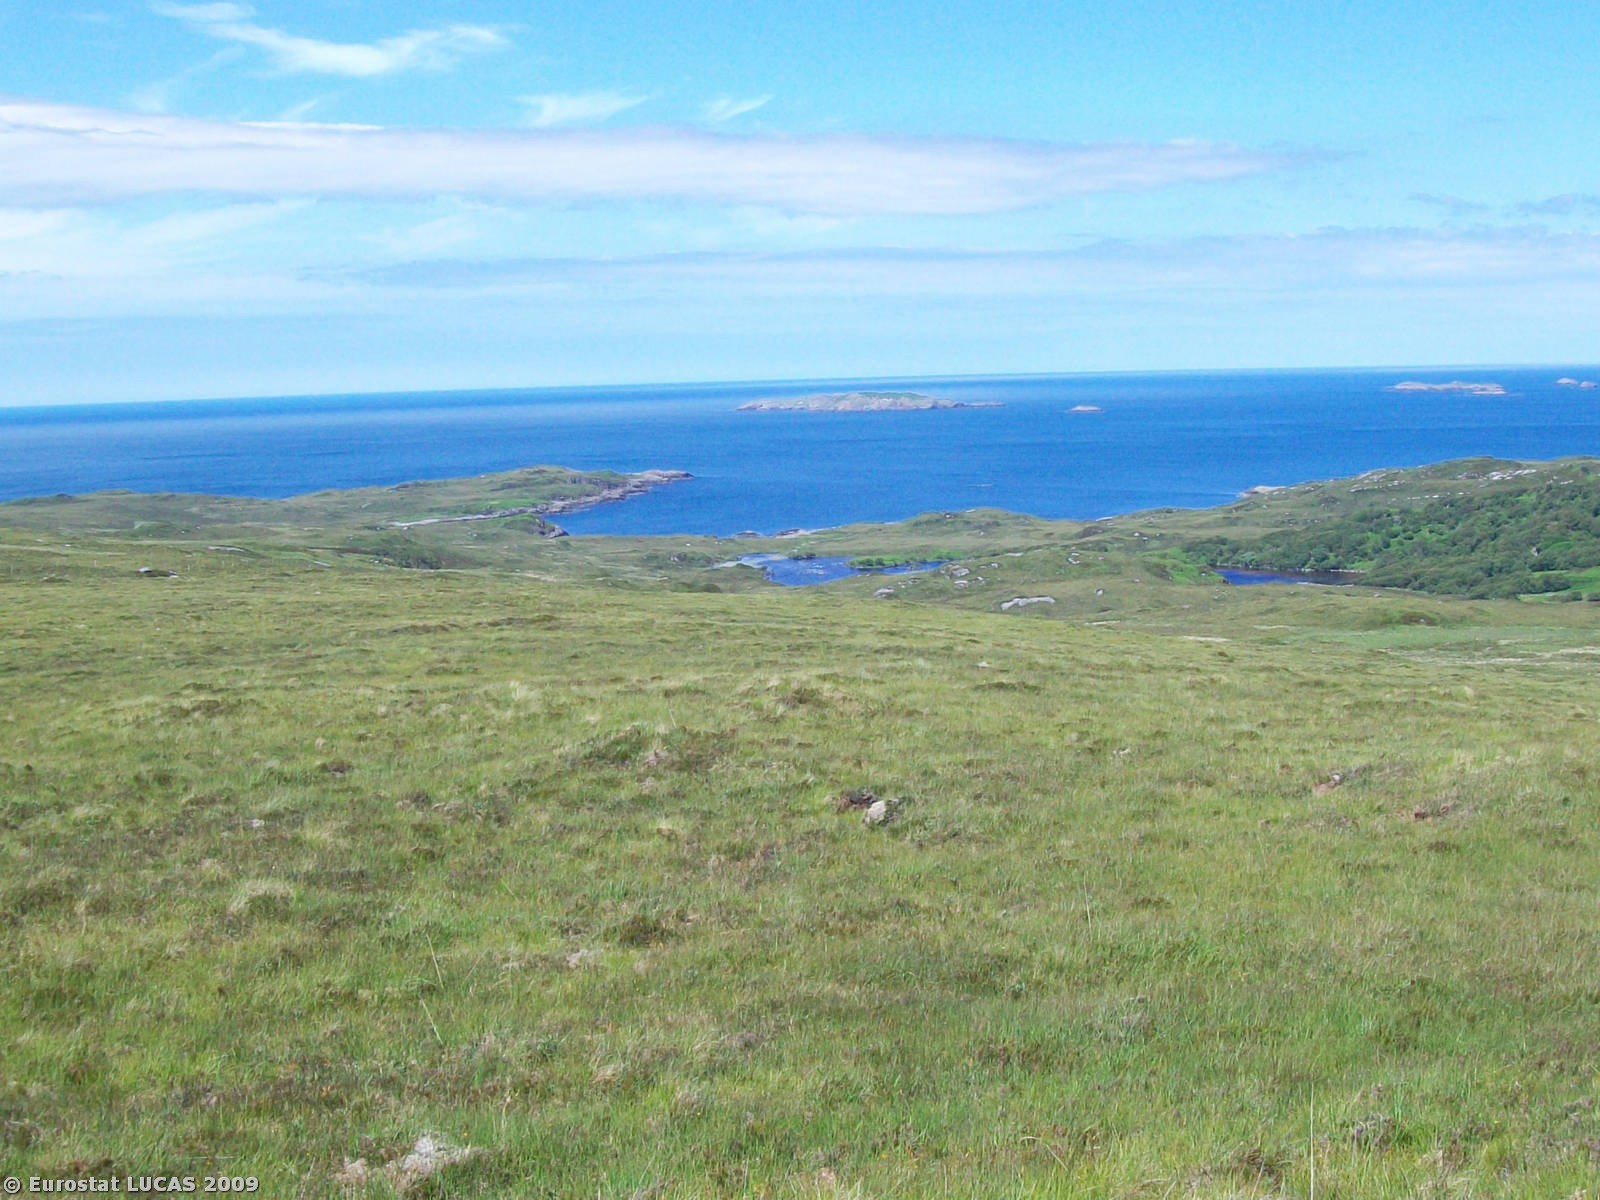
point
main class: Shrubland
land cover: Shrubland without tree cover
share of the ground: > 75 %
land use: Unused
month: June
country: GB
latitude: 58.2530
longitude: -5.1477
